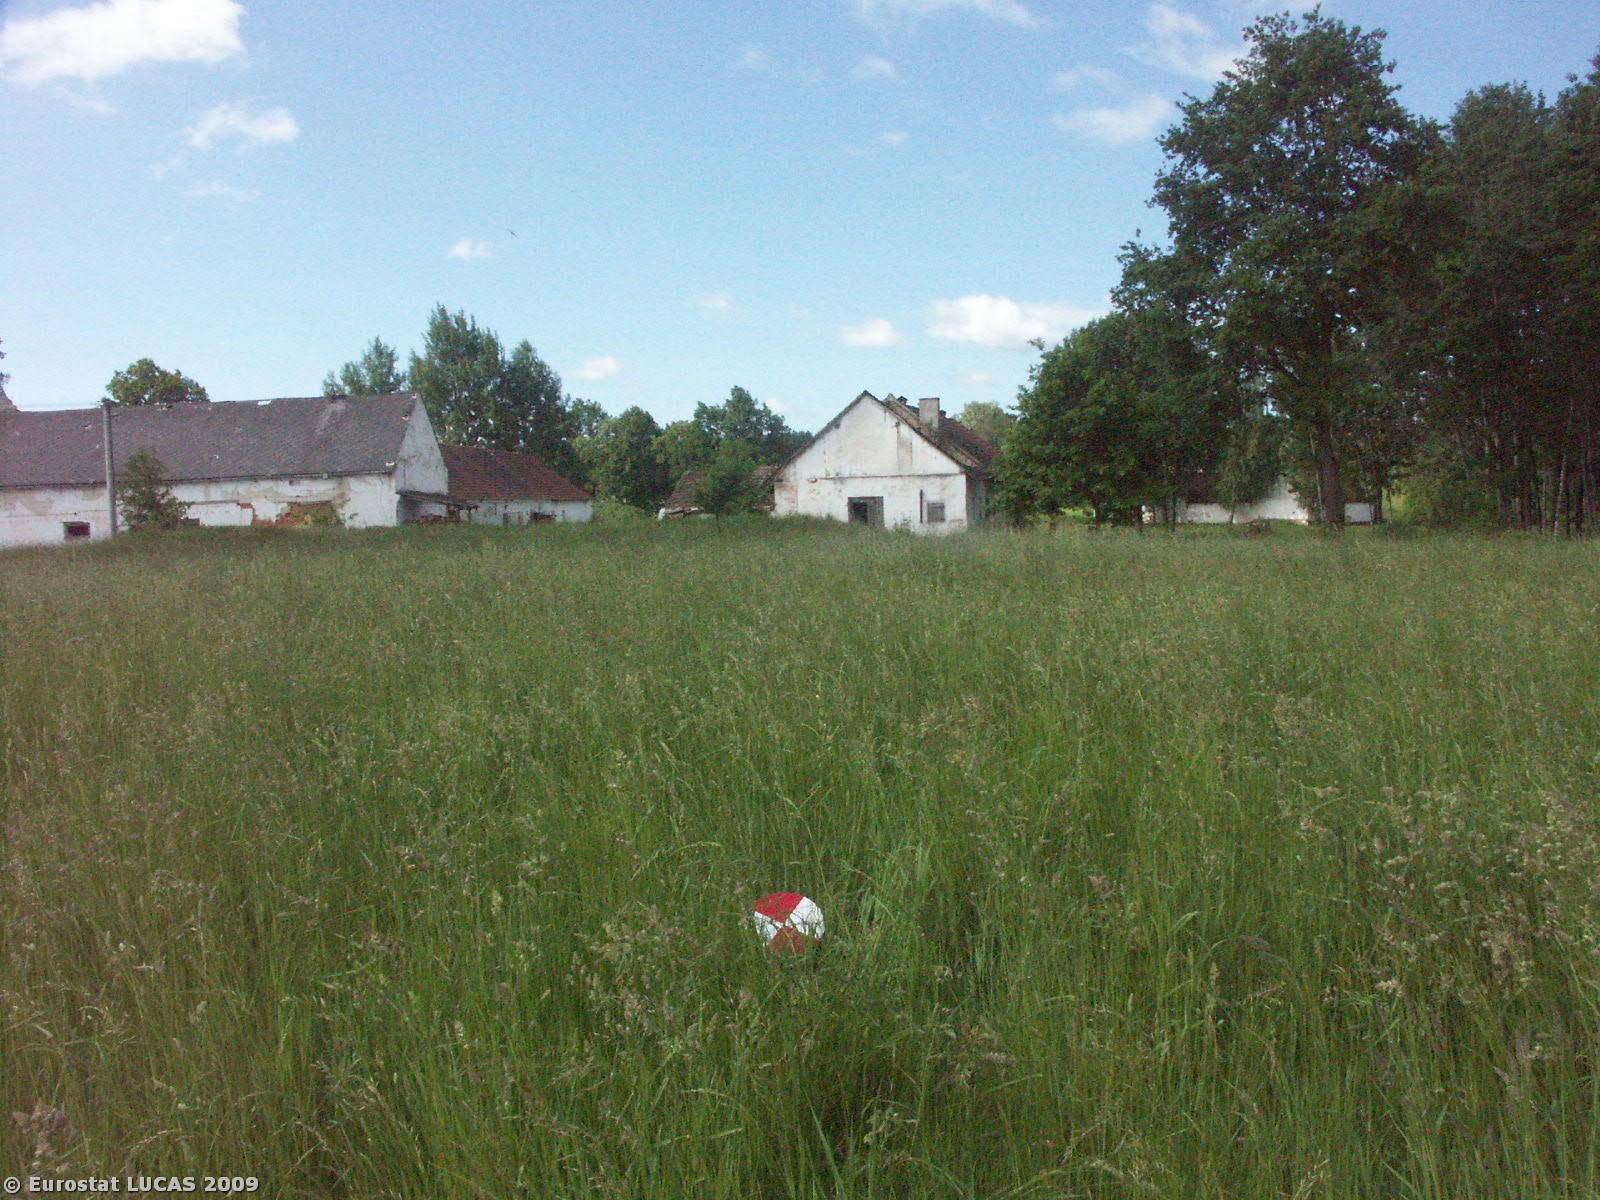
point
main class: Grassland
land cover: Grassland without tree/shrub cover
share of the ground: > 75 %
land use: Agriculture (excluding fallow land and kitchen gardens)
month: May
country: CZ
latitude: 48.9350
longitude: 14.6837
